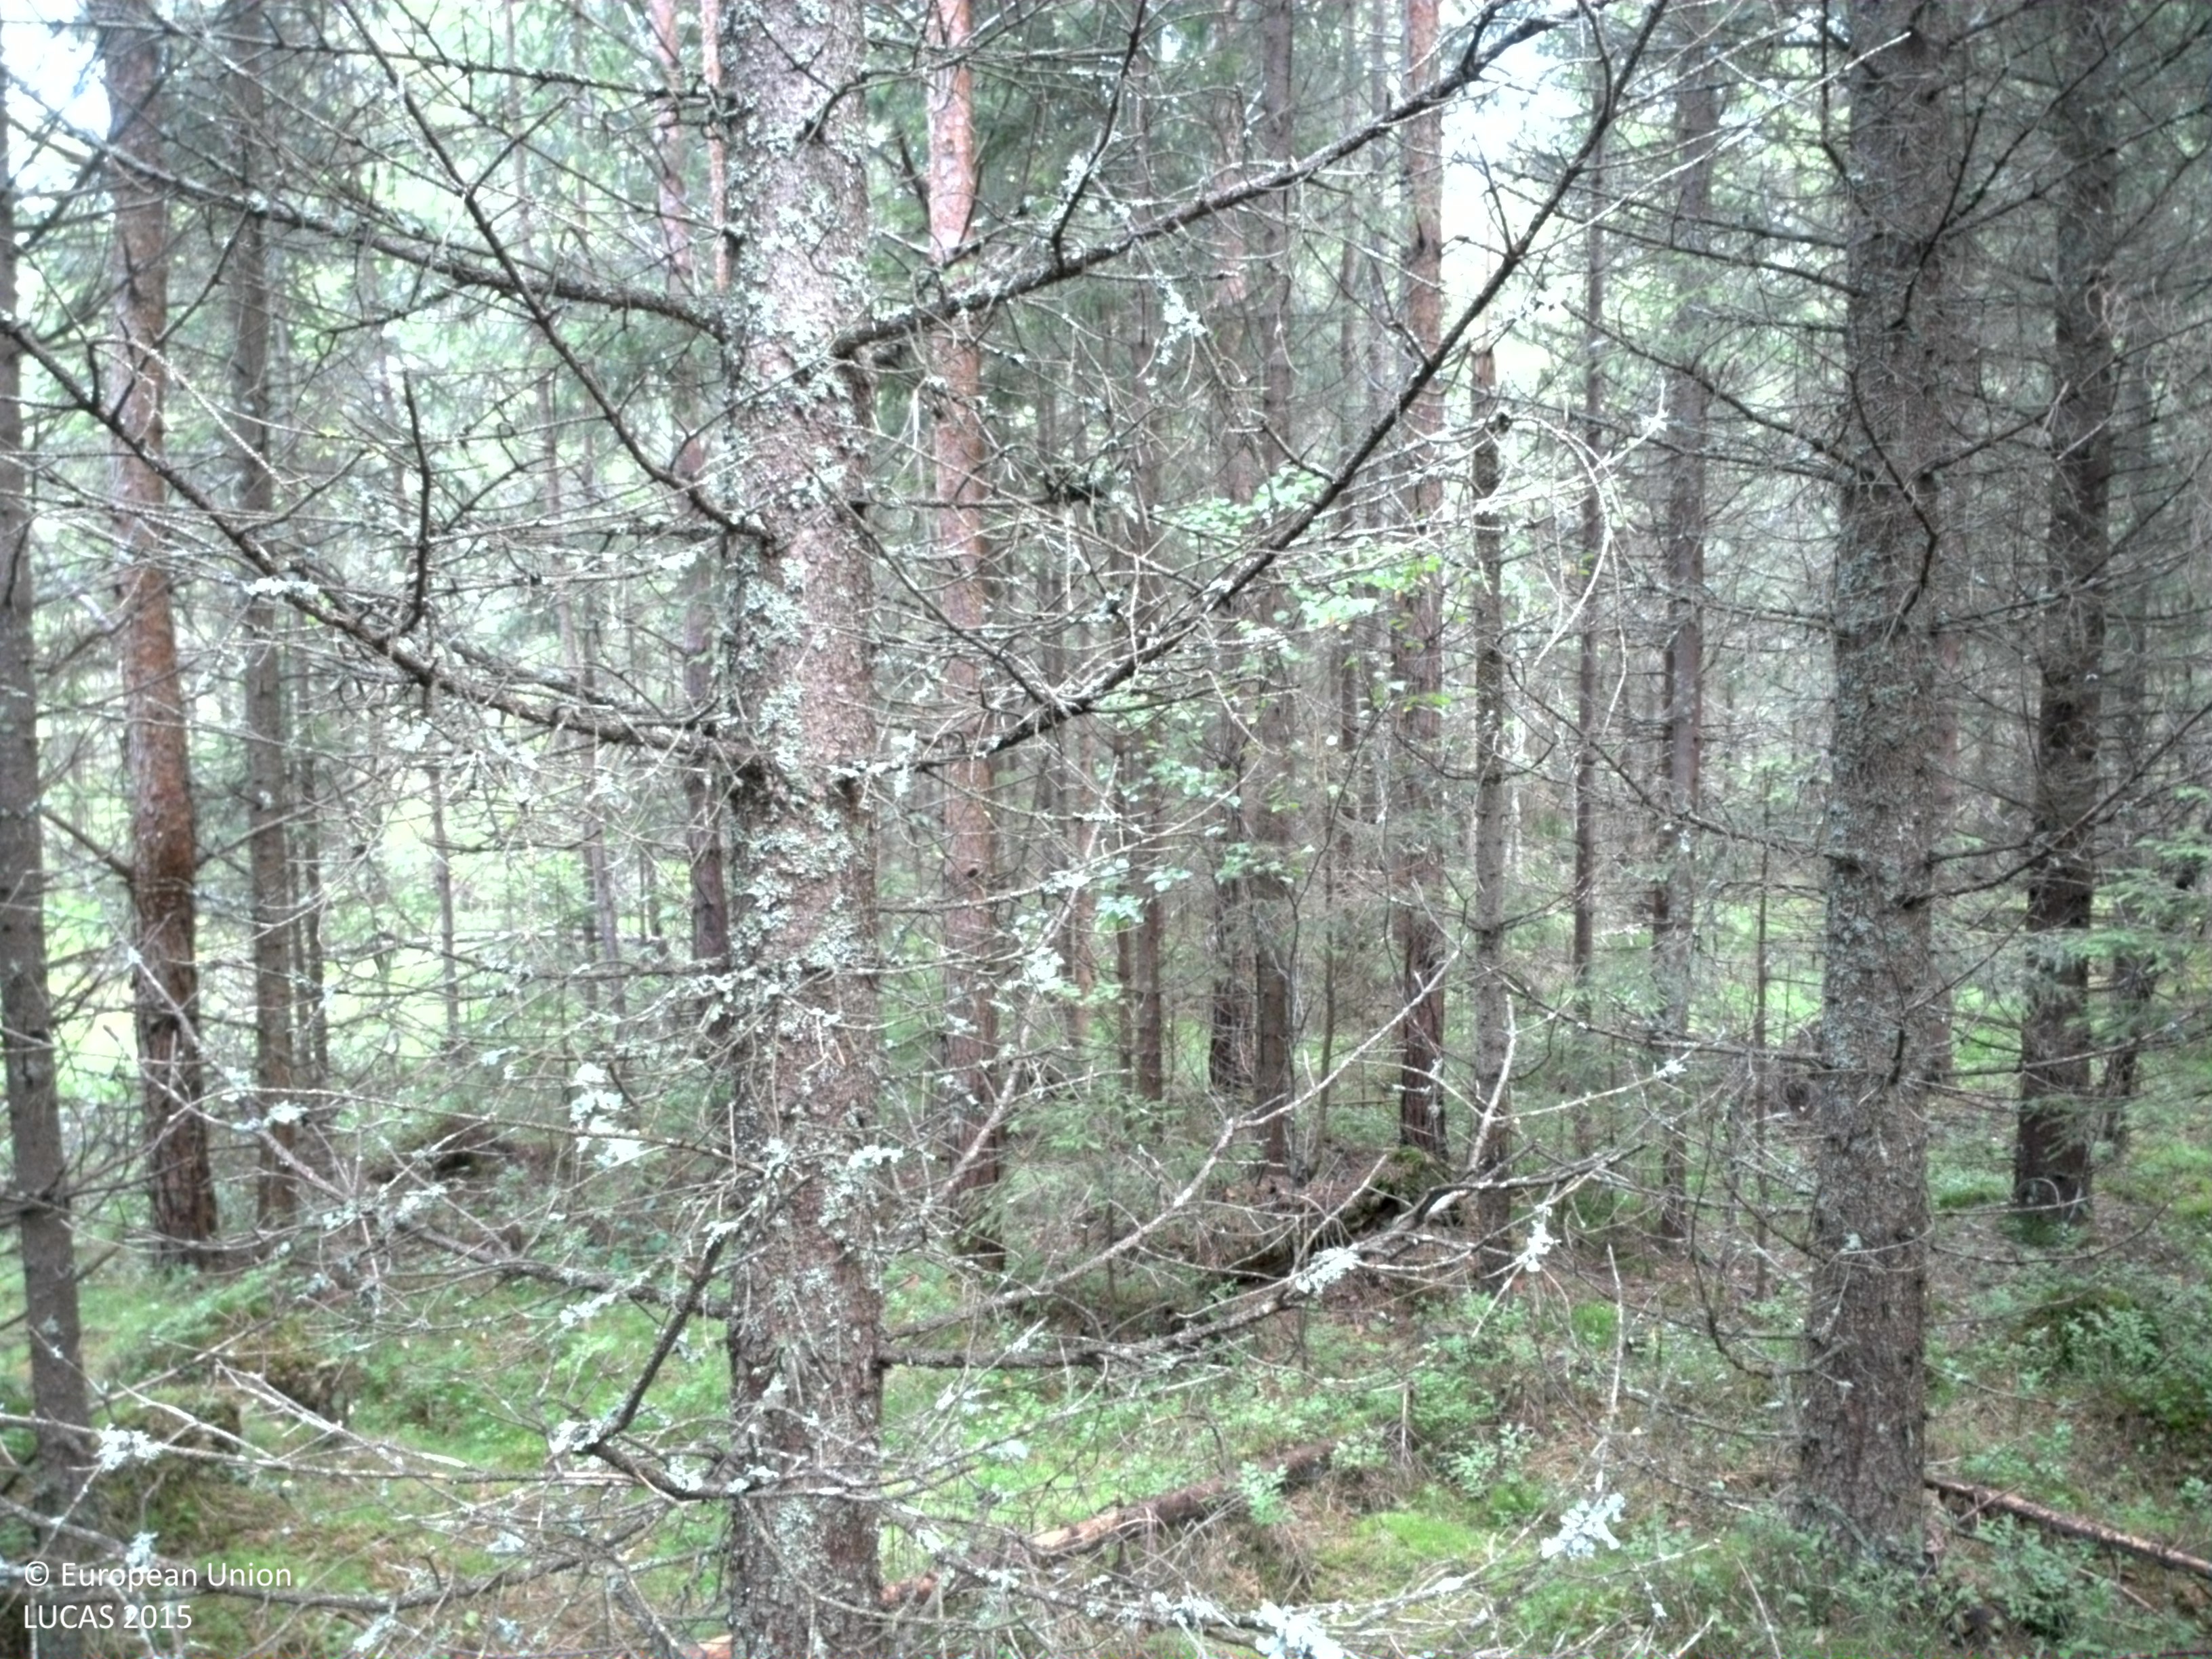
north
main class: Woodland
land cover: Other coniferous woodland
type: boreal forest
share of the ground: 50 - 75 %
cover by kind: coniferous forest trees 65 %, lichens and mosses 25 %, broadleaved forest trees 5 %, shrubs 5 %
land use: Forestry
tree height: > 5 m
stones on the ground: < 10 %
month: August
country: SE
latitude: 59.6203
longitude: 13.2716
